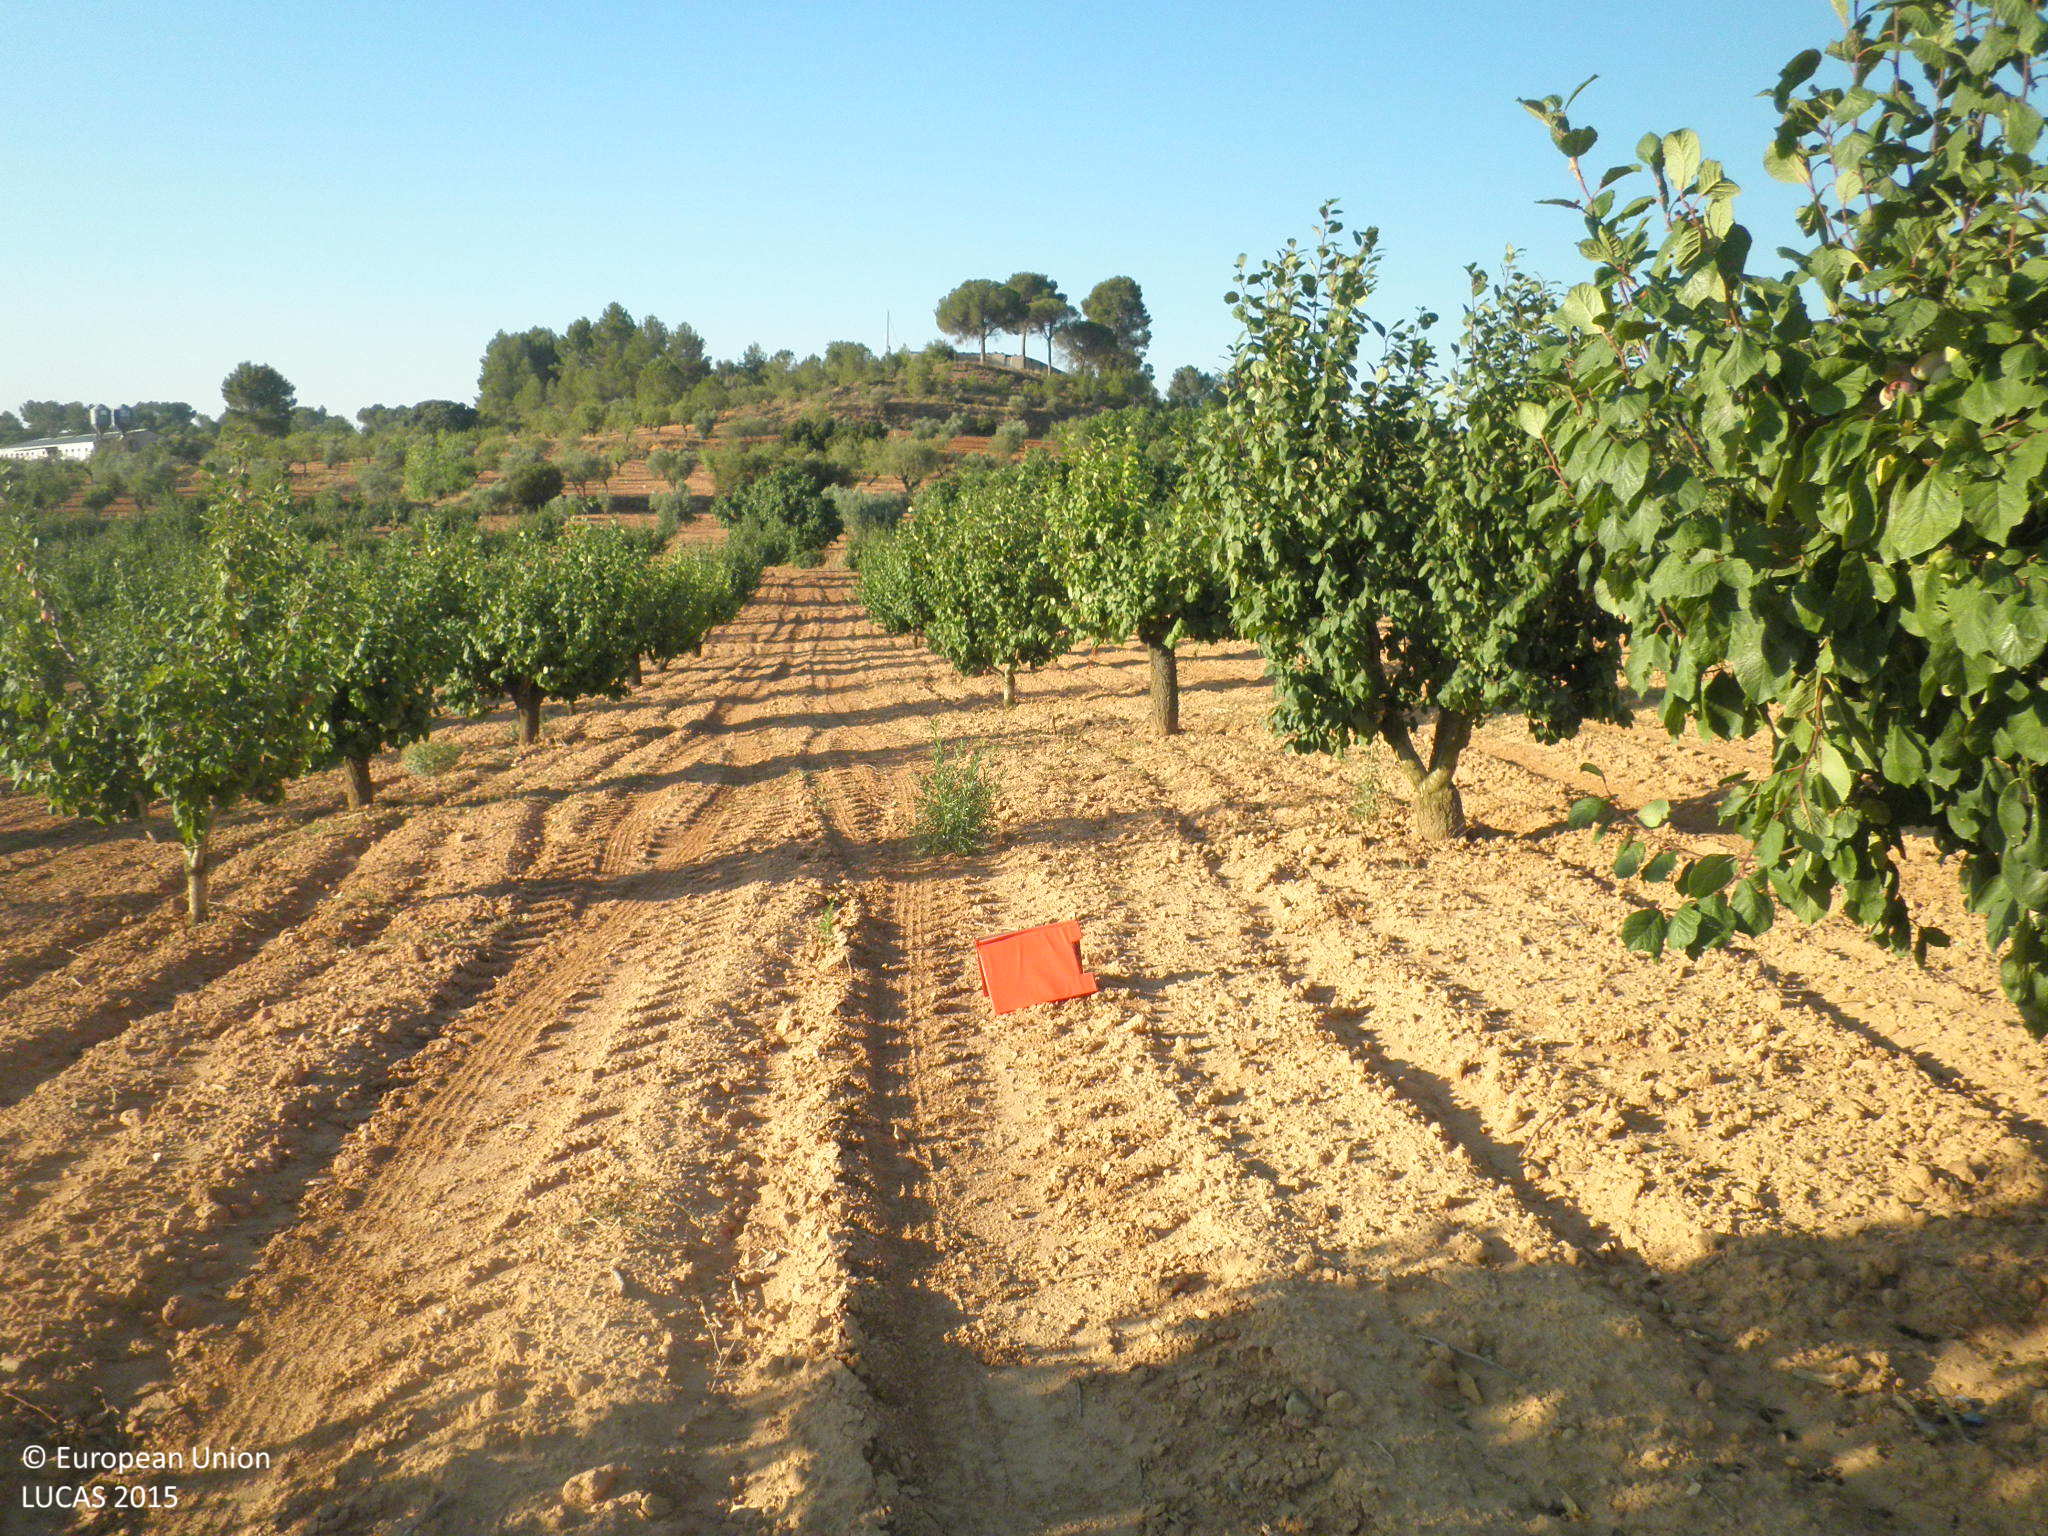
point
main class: Cropland
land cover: Other fruit trees and berries
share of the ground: 10 - 25 %
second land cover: Other bare soil
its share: > 75 %
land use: Agriculture (excluding fallow land and kitchen gardens)
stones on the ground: < 10 %
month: July
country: ES
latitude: 39.3786
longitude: -1.5771
